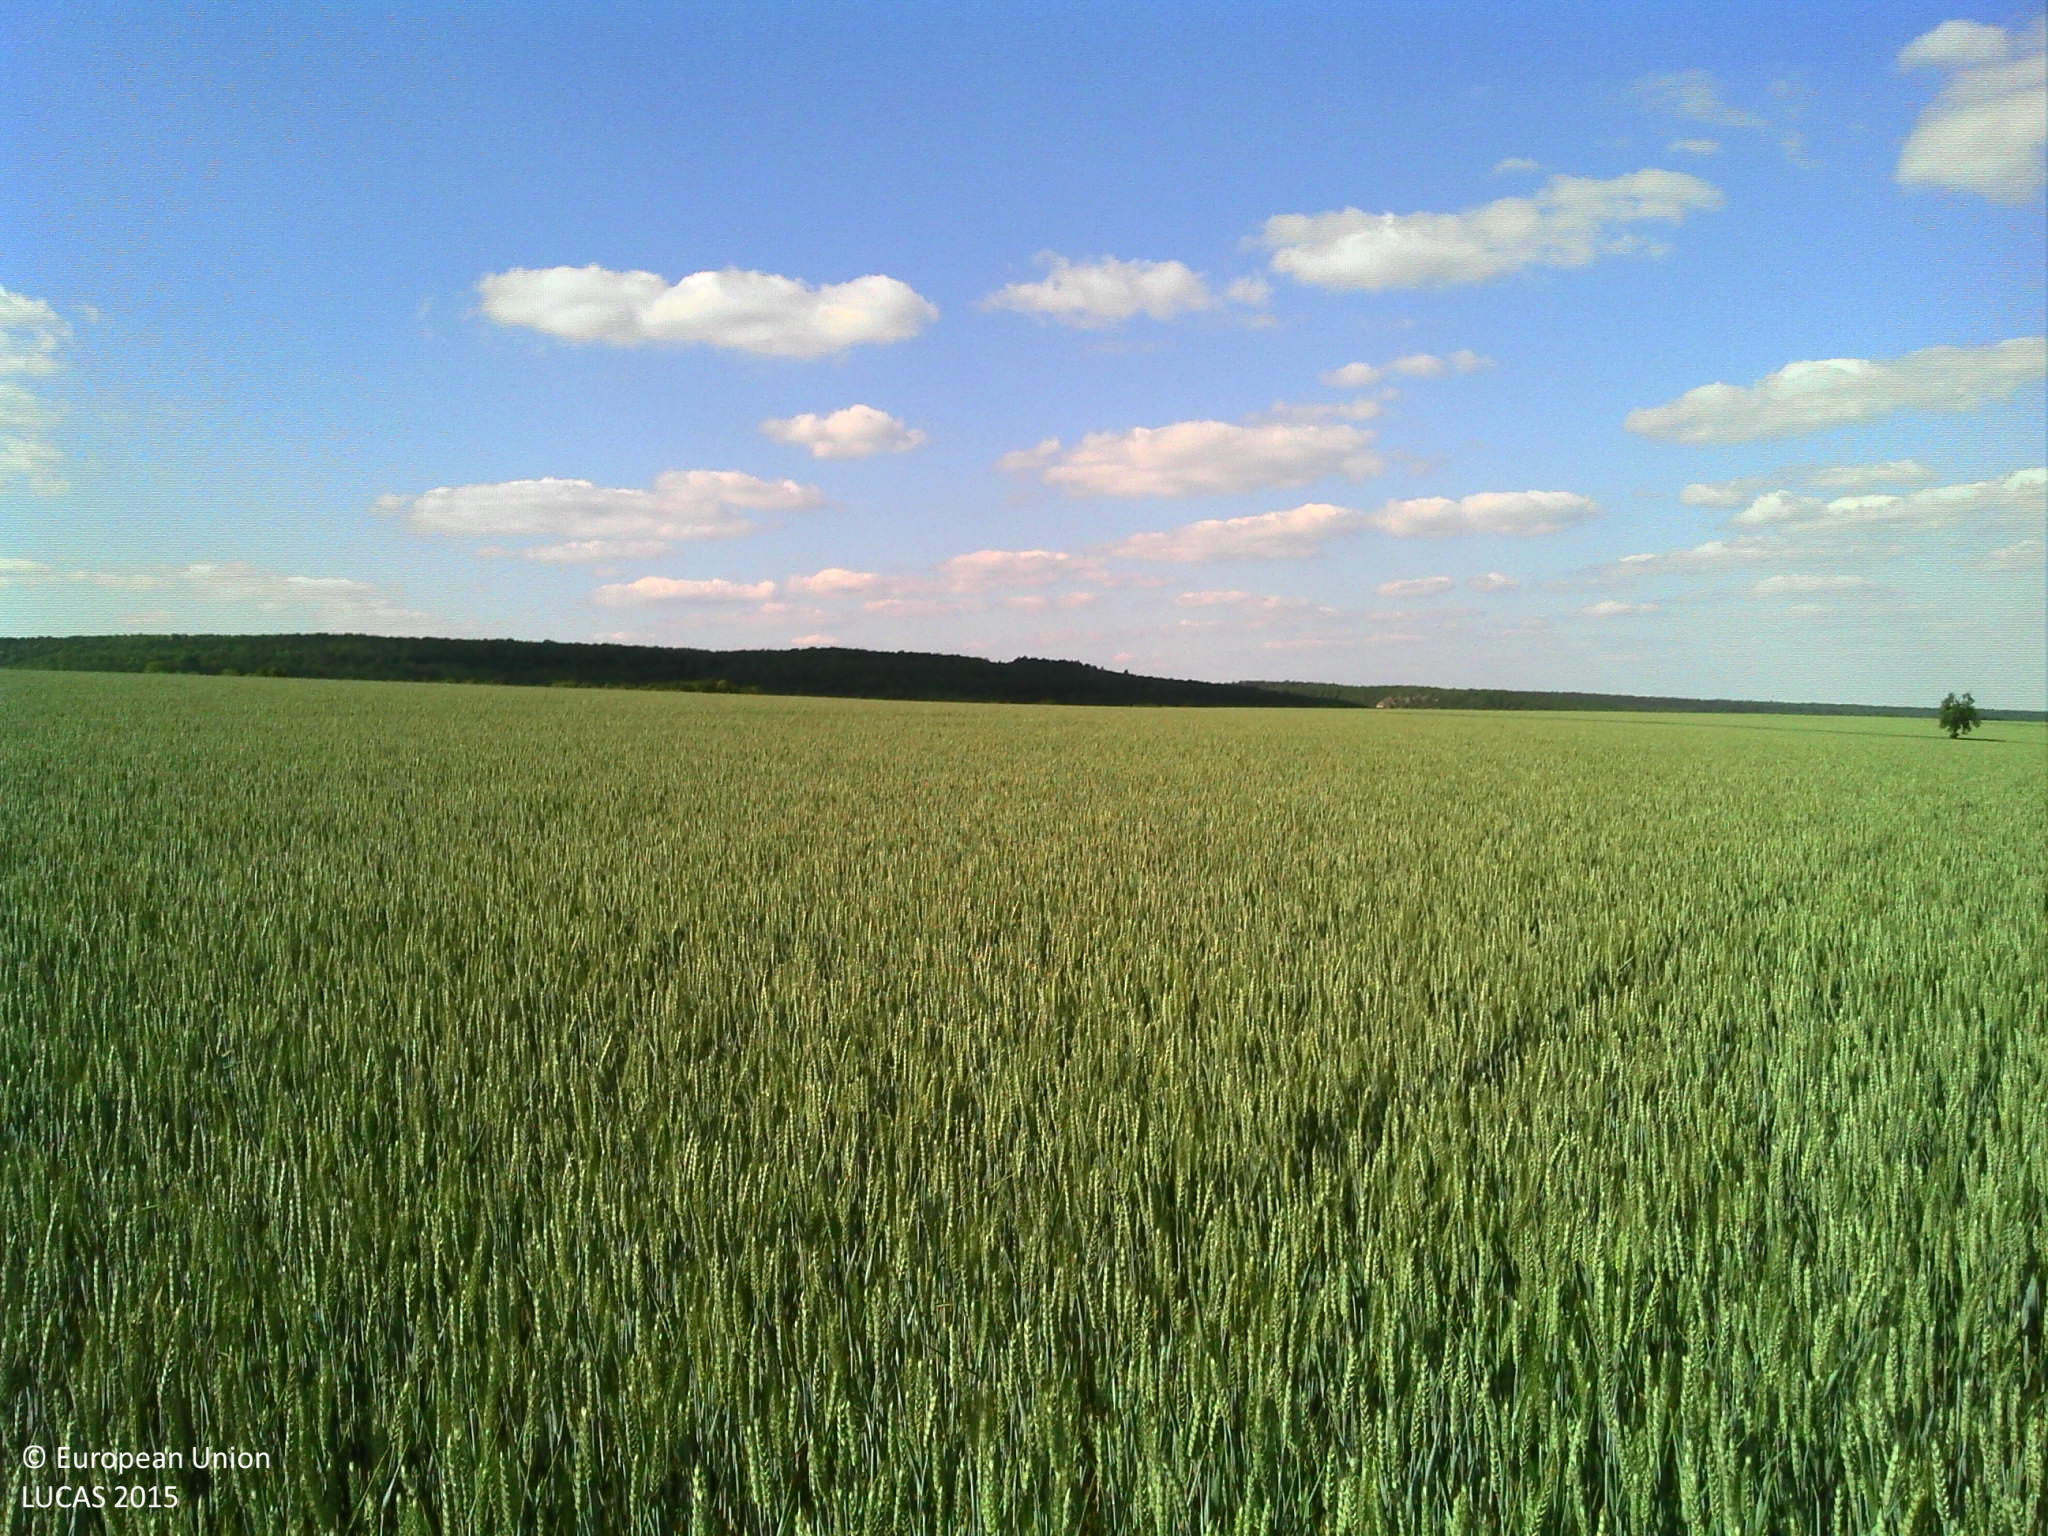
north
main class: Cropland
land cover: Common wheat
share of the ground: > 75 %
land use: Agriculture (excluding fallow land and kitchen gardens)
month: May
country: FR
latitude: 47.3879
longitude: 4.9796
